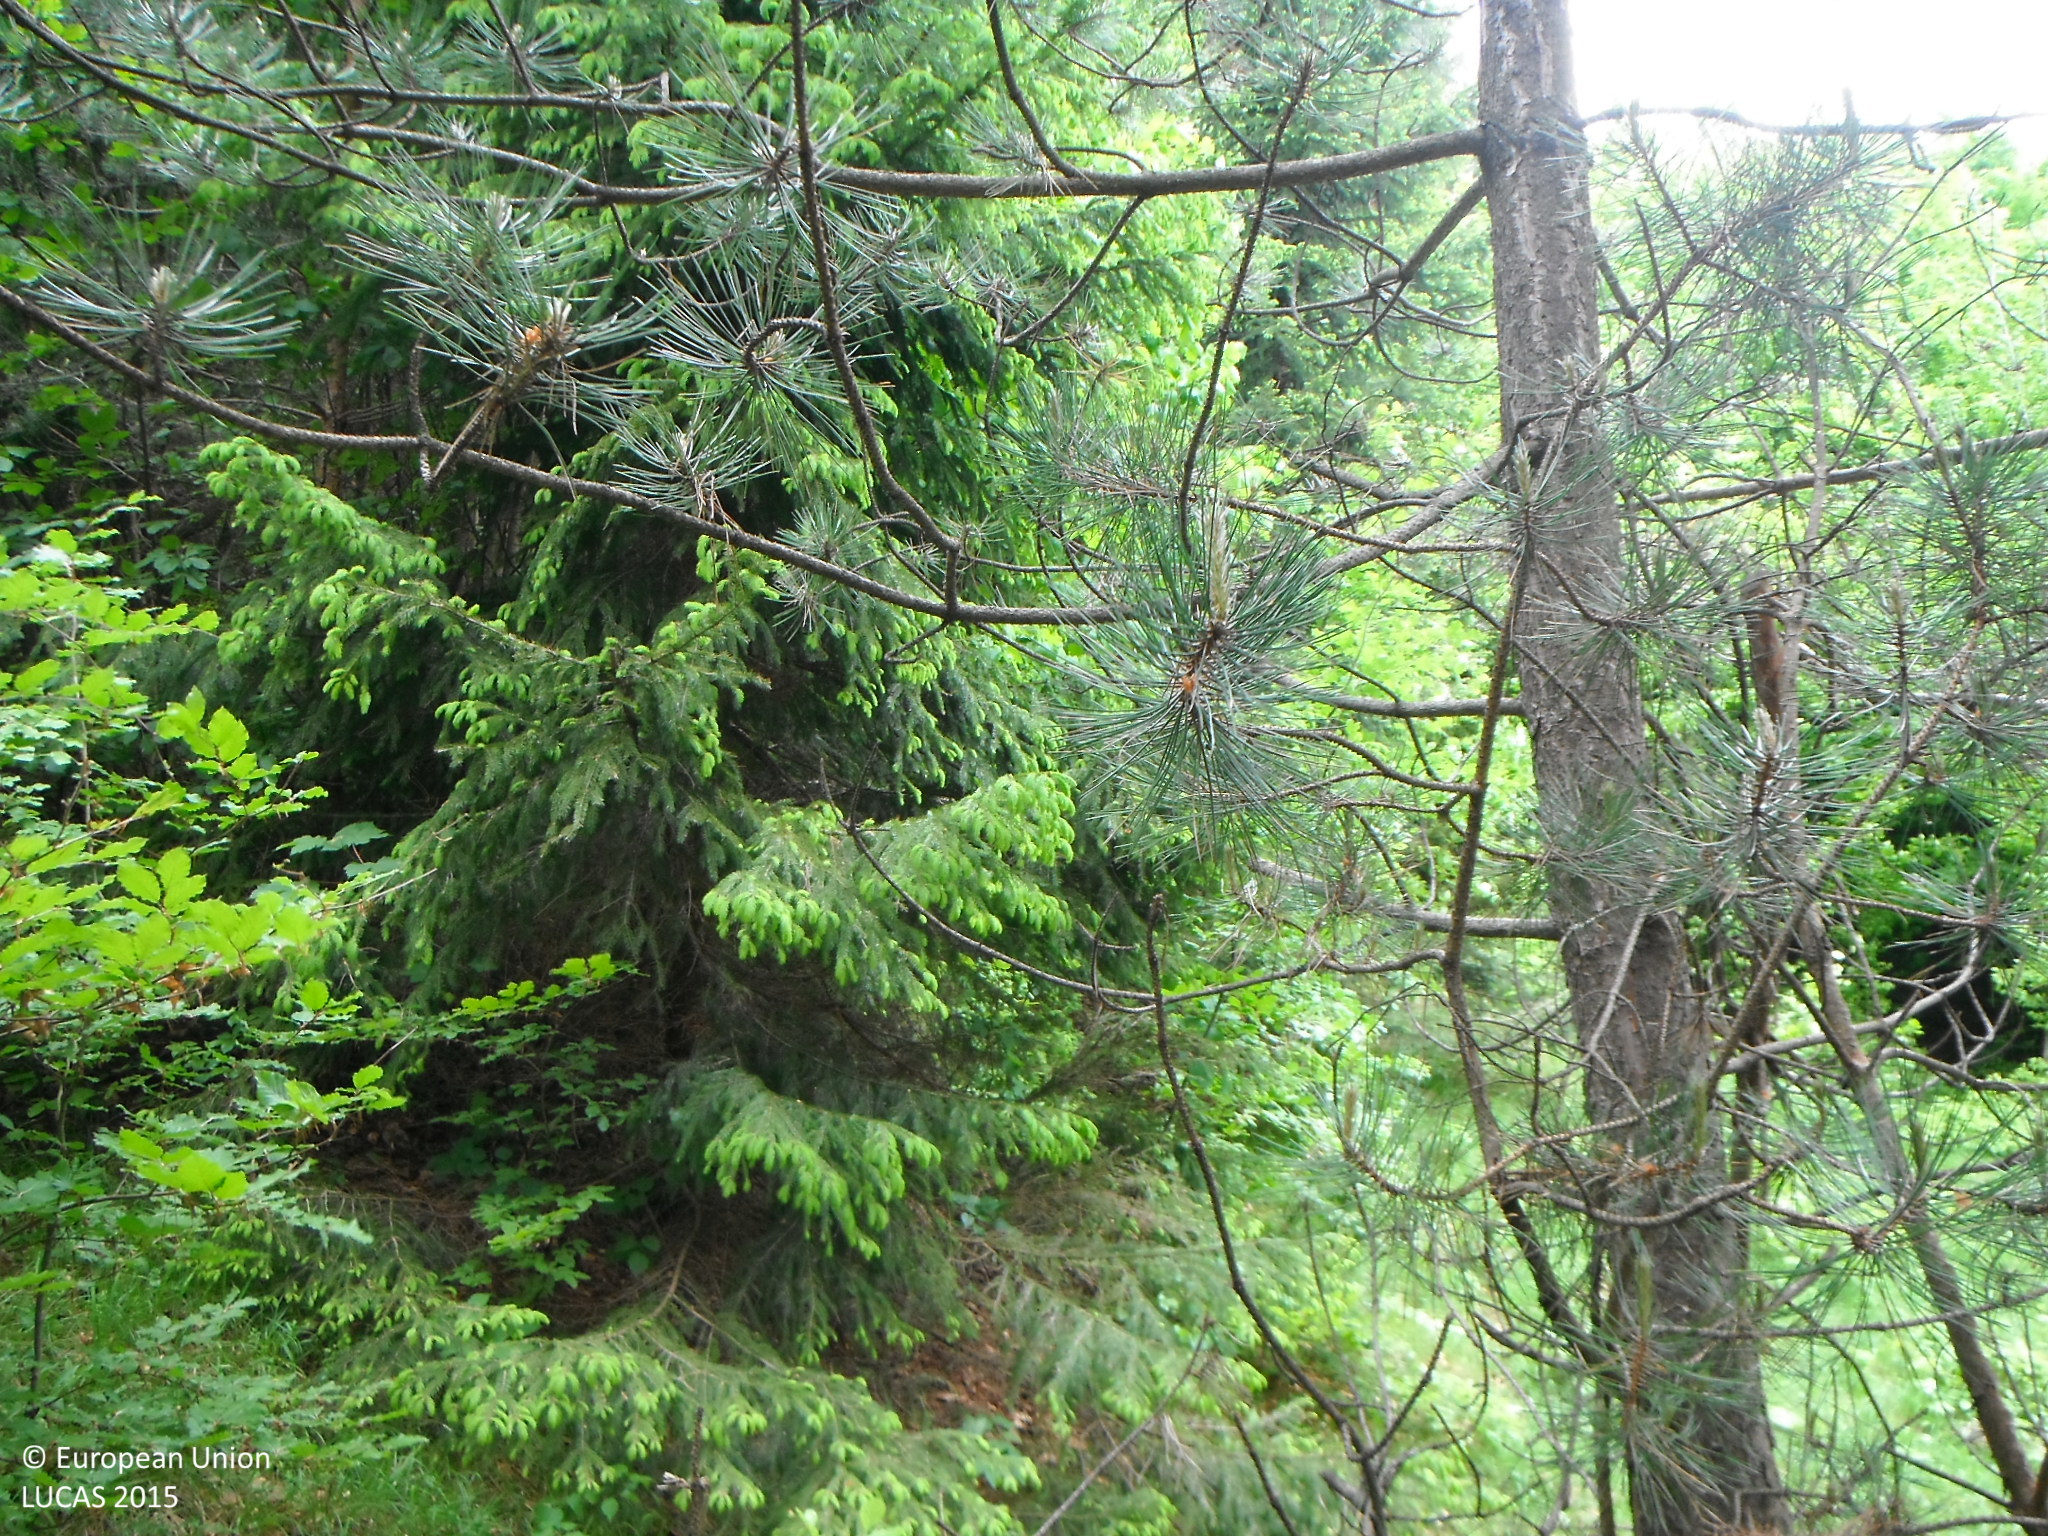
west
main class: Woodland
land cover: Pine dominated mixed woodland
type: hemiboreal forest and nemoral coniferous forest and mixed broadleaved-coniferous forest
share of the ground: > 75 %
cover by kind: broadleaved forest trees 55 %, coniferous forest trees 40 %, herbaceous plants 5 %
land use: Forestry
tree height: > 5 m
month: May
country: SK
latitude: 48.7545
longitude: 19.0670
